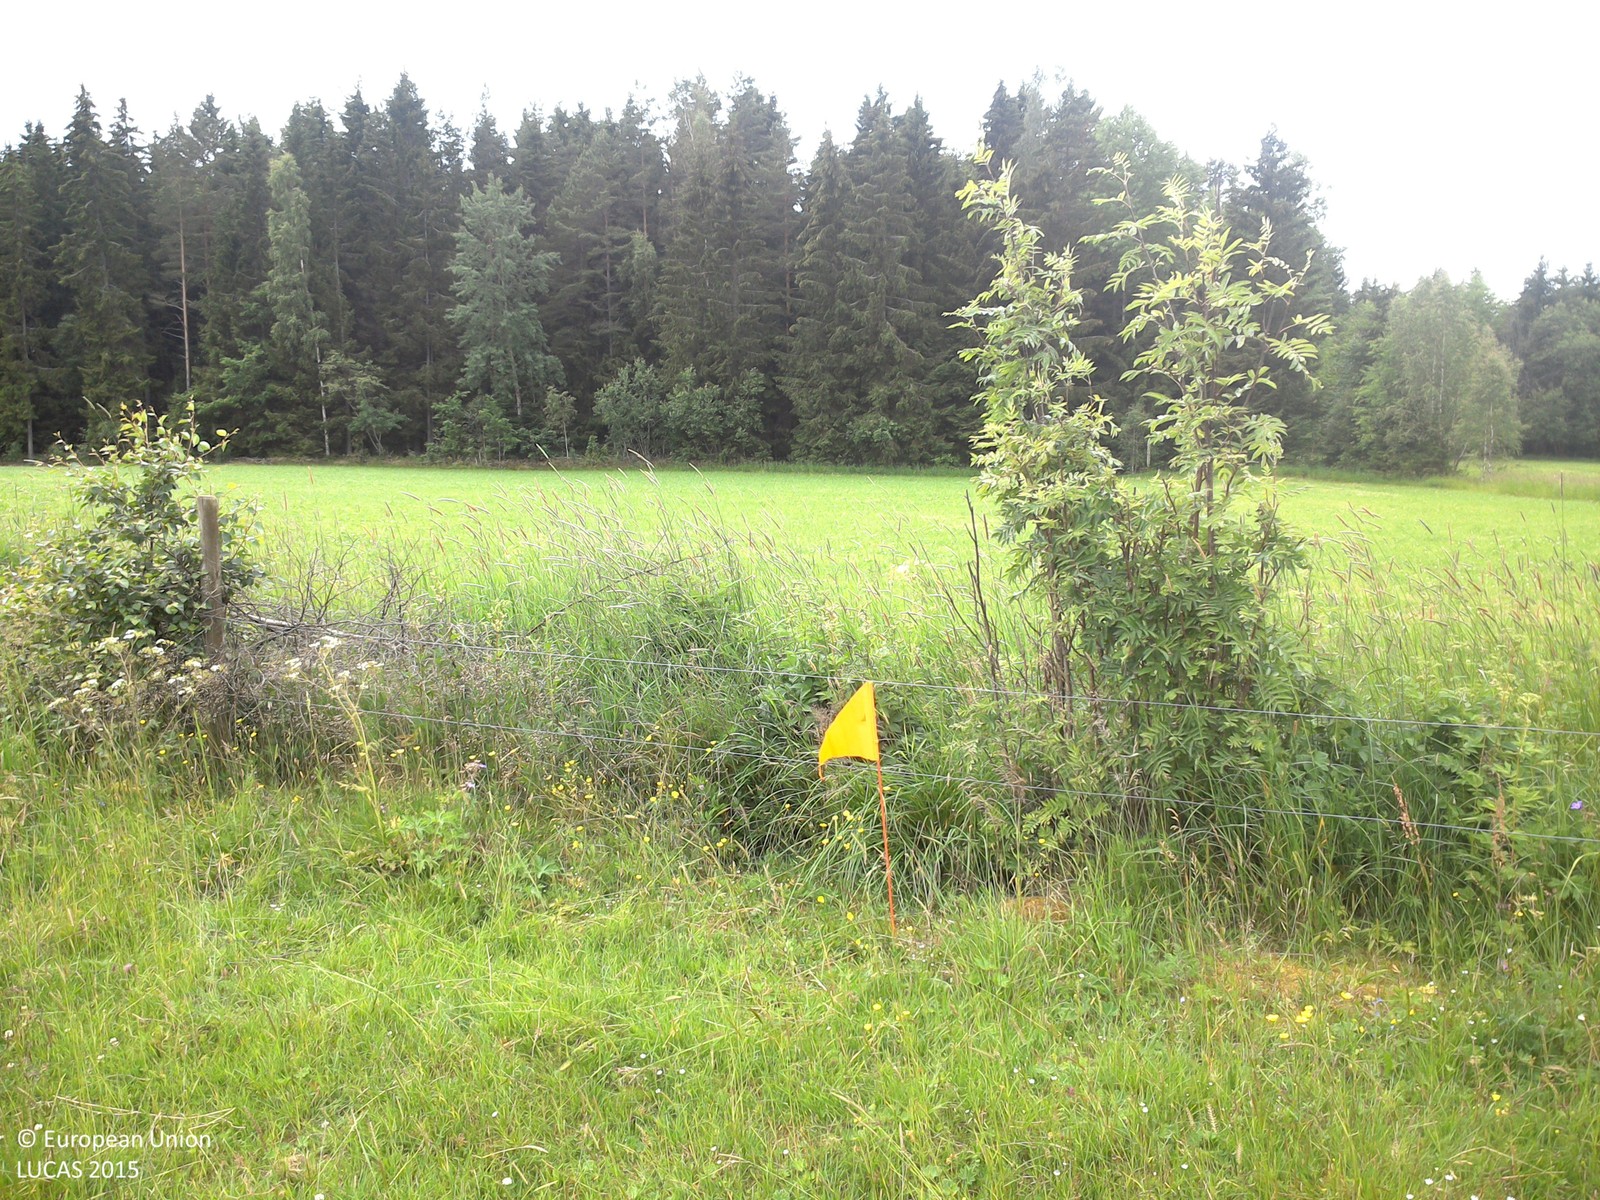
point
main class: Grassland
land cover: Grassland without tree/shrub cover
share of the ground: > 75 %
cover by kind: herbaceous plants 100 %
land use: Agriculture (excluding fallow land and kitchen gardens)
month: June
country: SE
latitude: 58.3065
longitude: 15.4726
